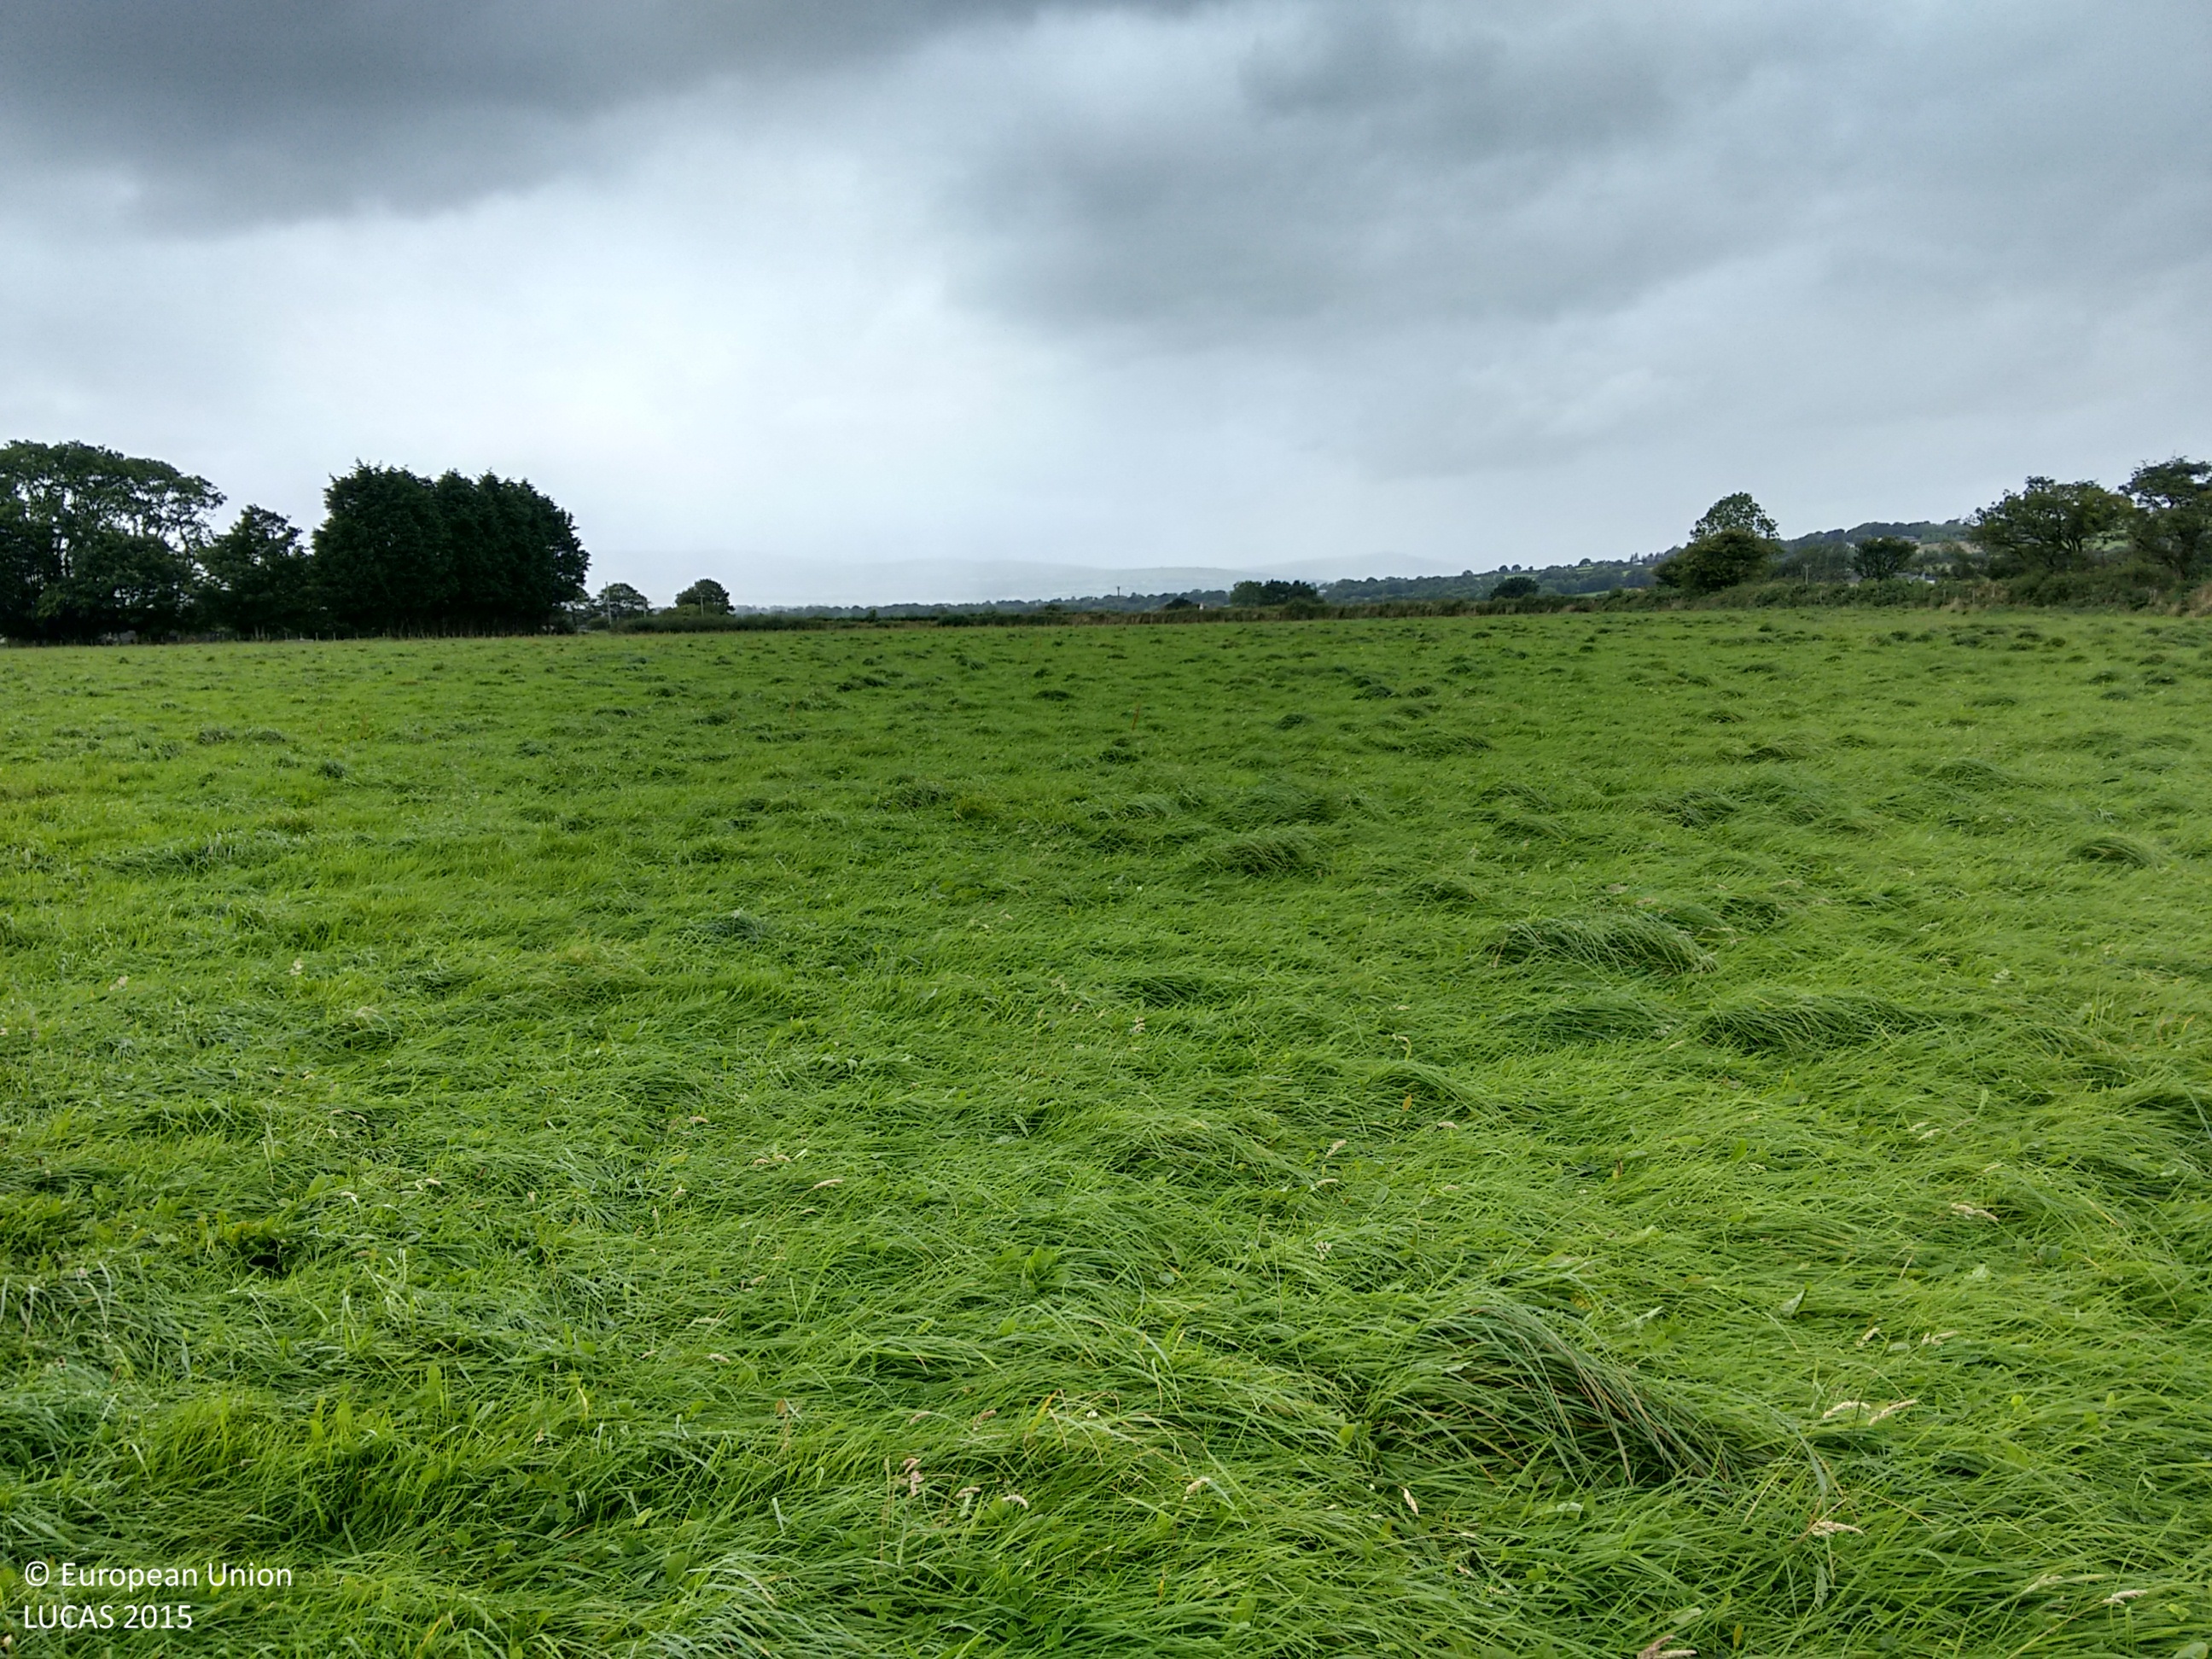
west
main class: Grassland
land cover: Grassland without tree/shrub cover
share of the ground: > 75 %
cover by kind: herbaceous plants 100 %
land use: Agriculture (excluding fallow land and kitchen gardens)
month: August
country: GB
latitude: 52.0123
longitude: -4.6347
